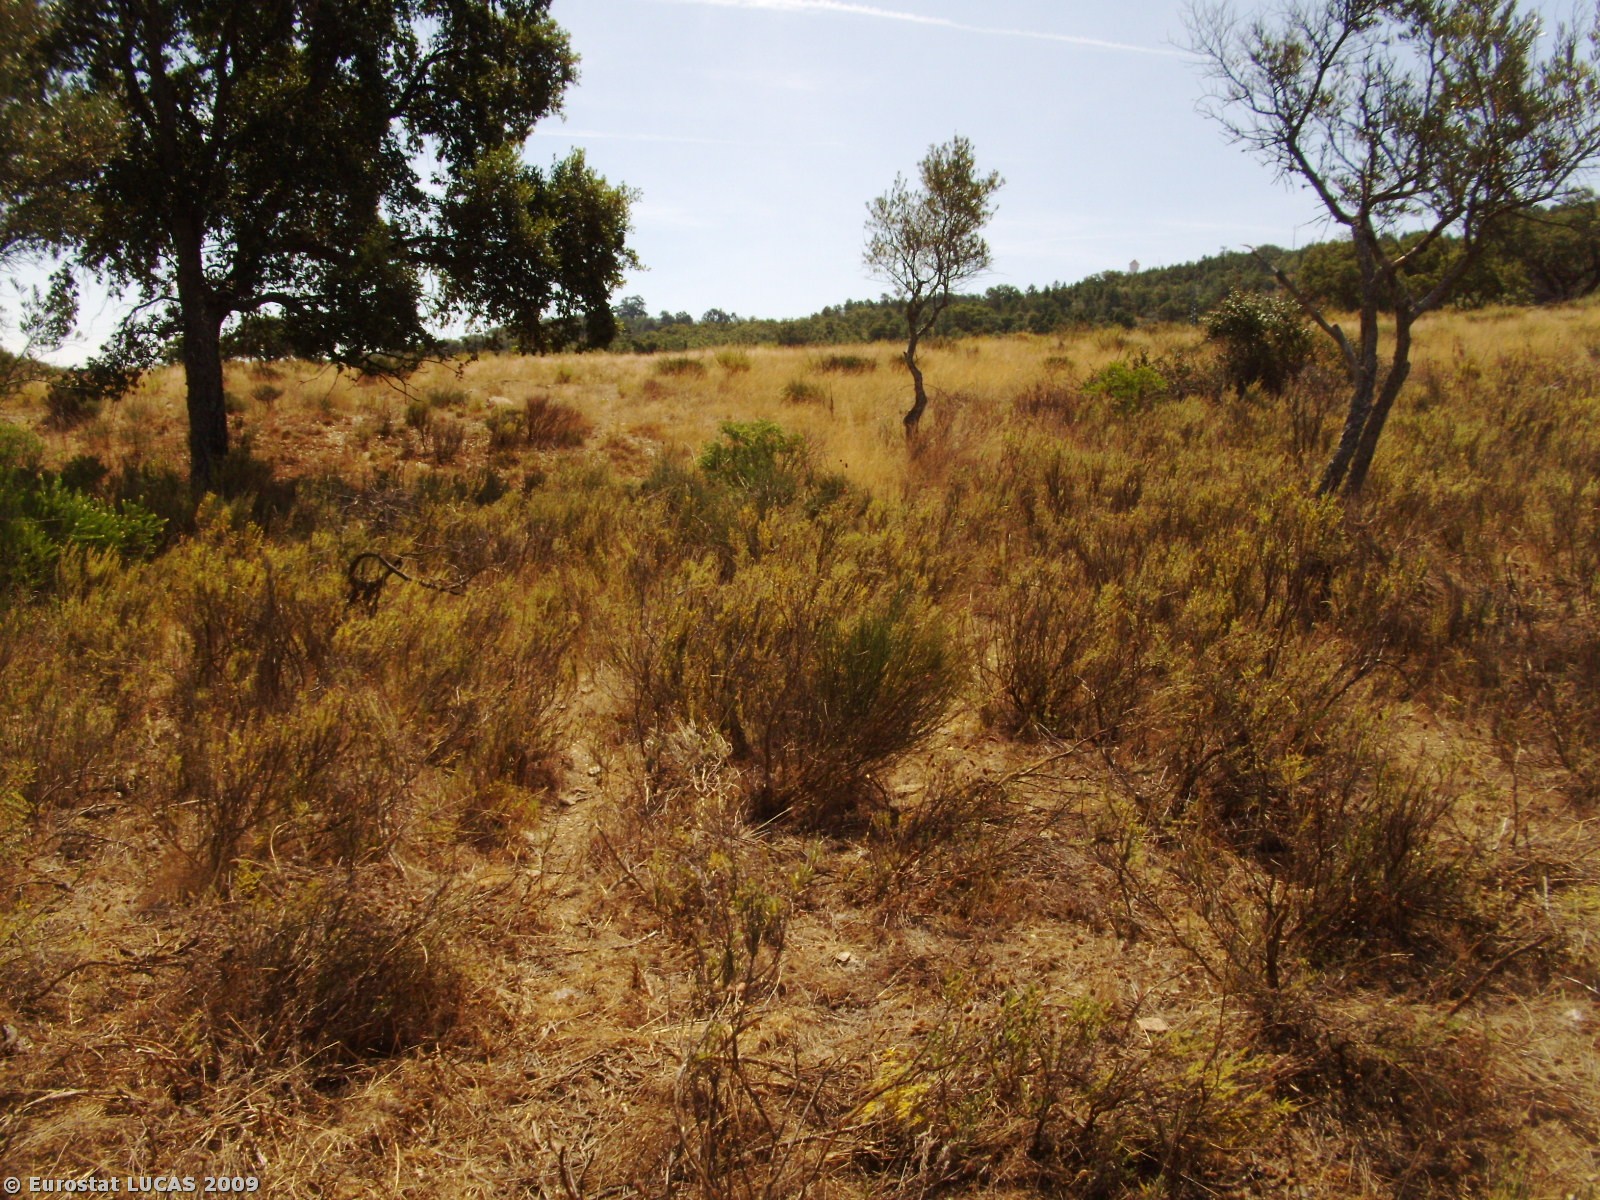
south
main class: Shrubland
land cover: Shrubland with sparse tree cover
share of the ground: > 75 %
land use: Fallow land
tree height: > 5 m
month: June
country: PT
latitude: 40.1769
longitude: -7.1848
